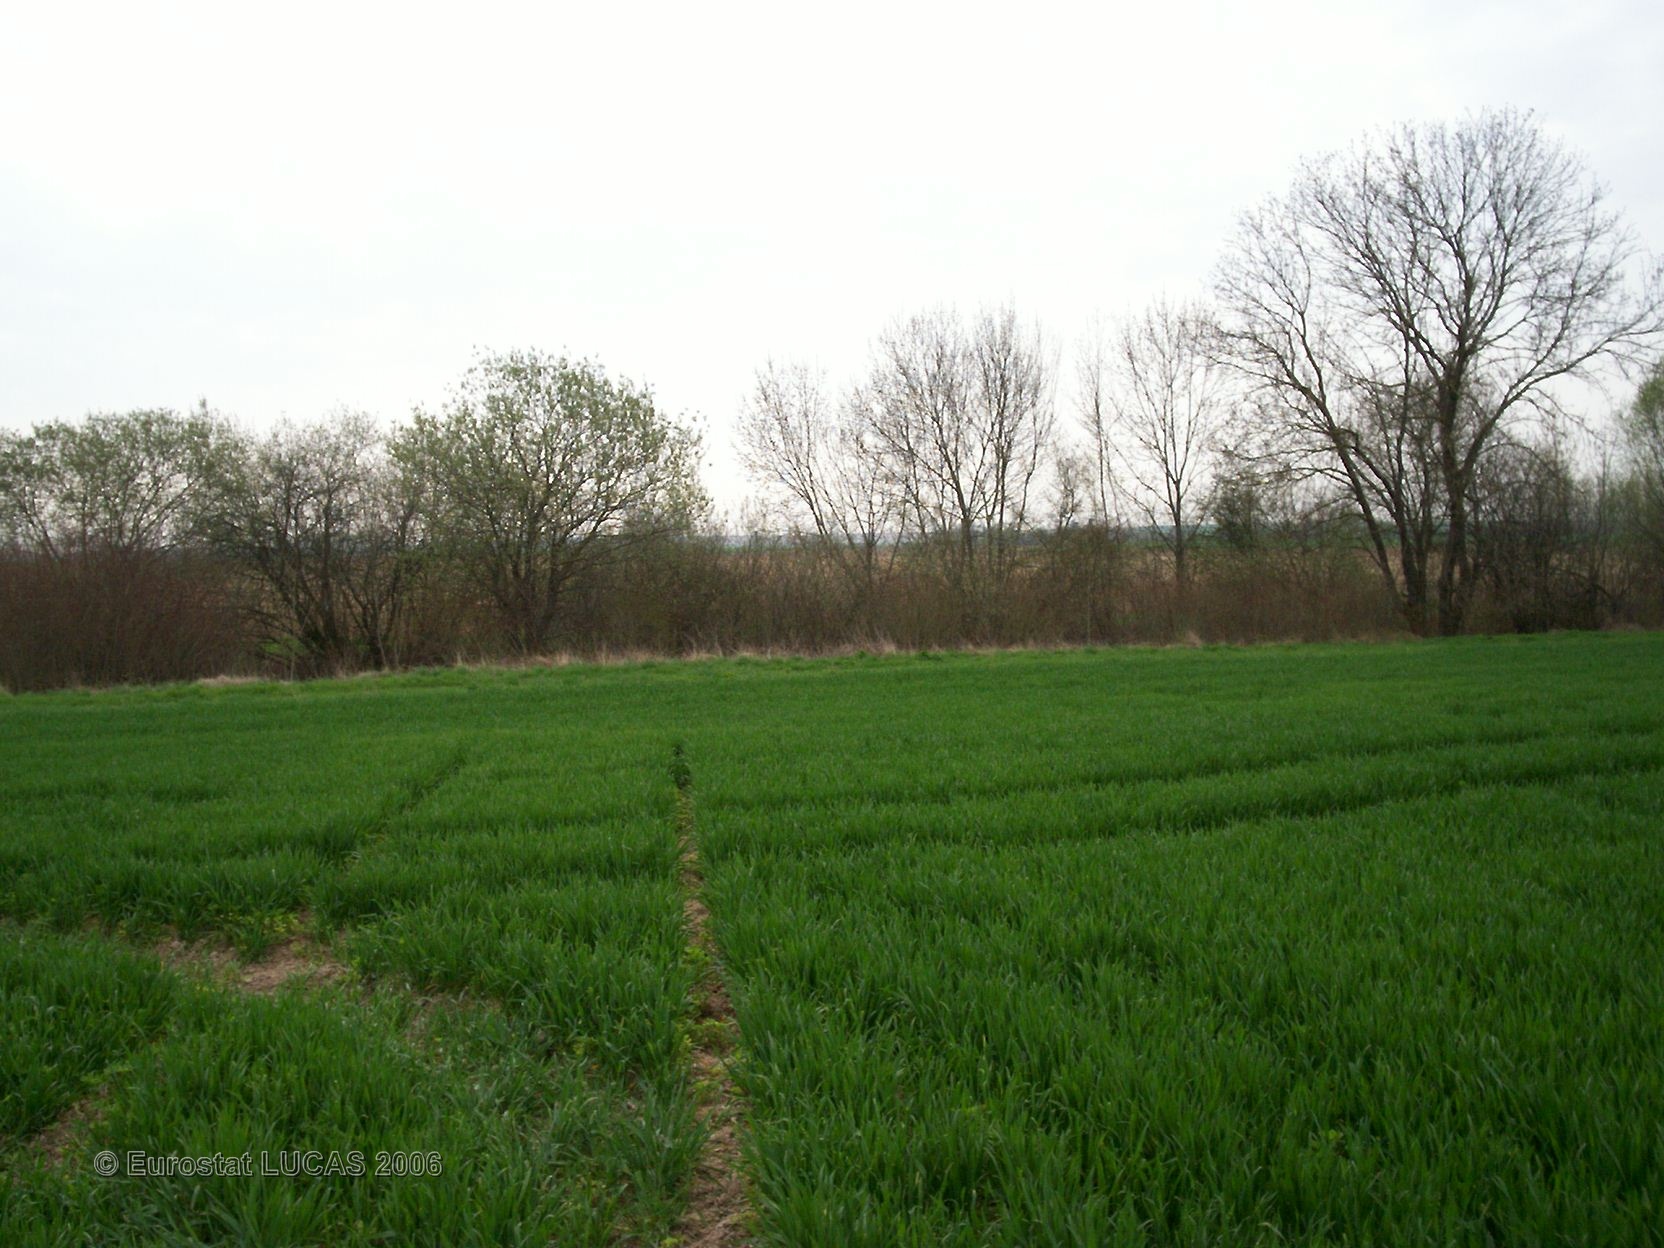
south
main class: Cropland
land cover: Common wheat
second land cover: Lucerne
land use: Agriculture (excluding fallow land and kitchen gardens)
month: April
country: FR
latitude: 48.6531
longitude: 3.9547
